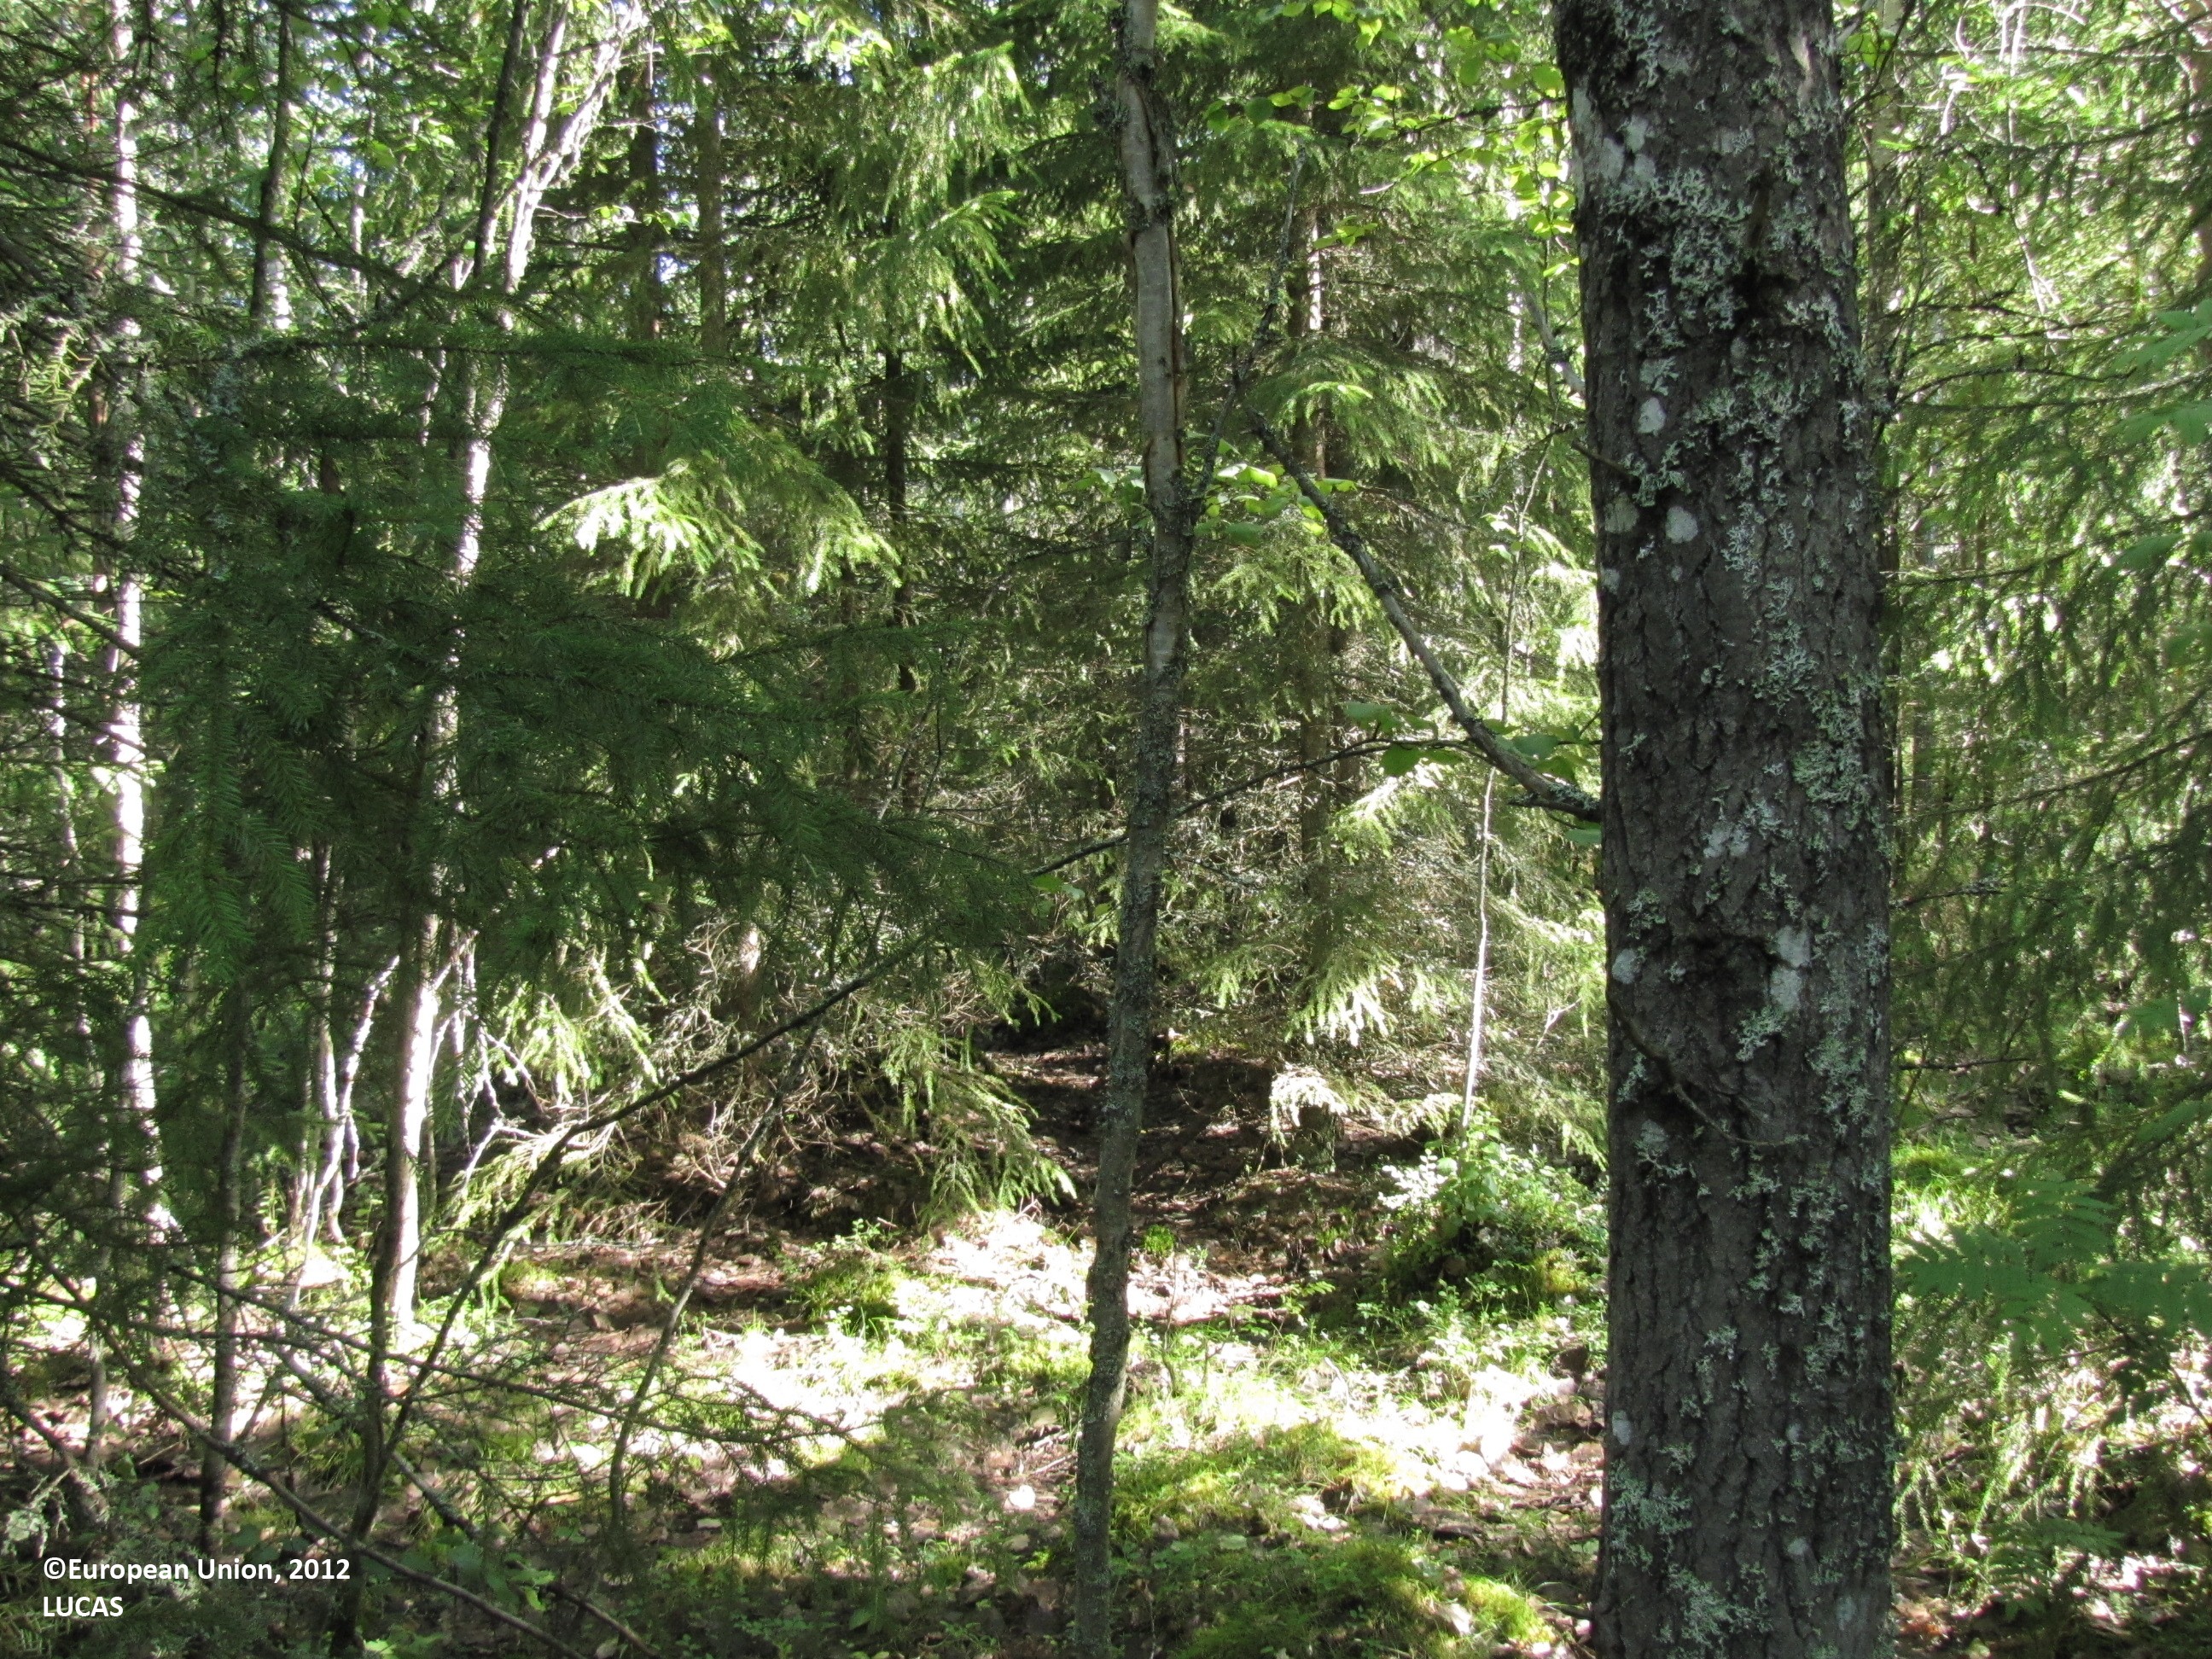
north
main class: Woodland
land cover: Other mixed woodland
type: boreal forest
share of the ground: > 75 %
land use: Forestry
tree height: > 5 m
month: July
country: FI
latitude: 62.0910
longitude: 23.1099
